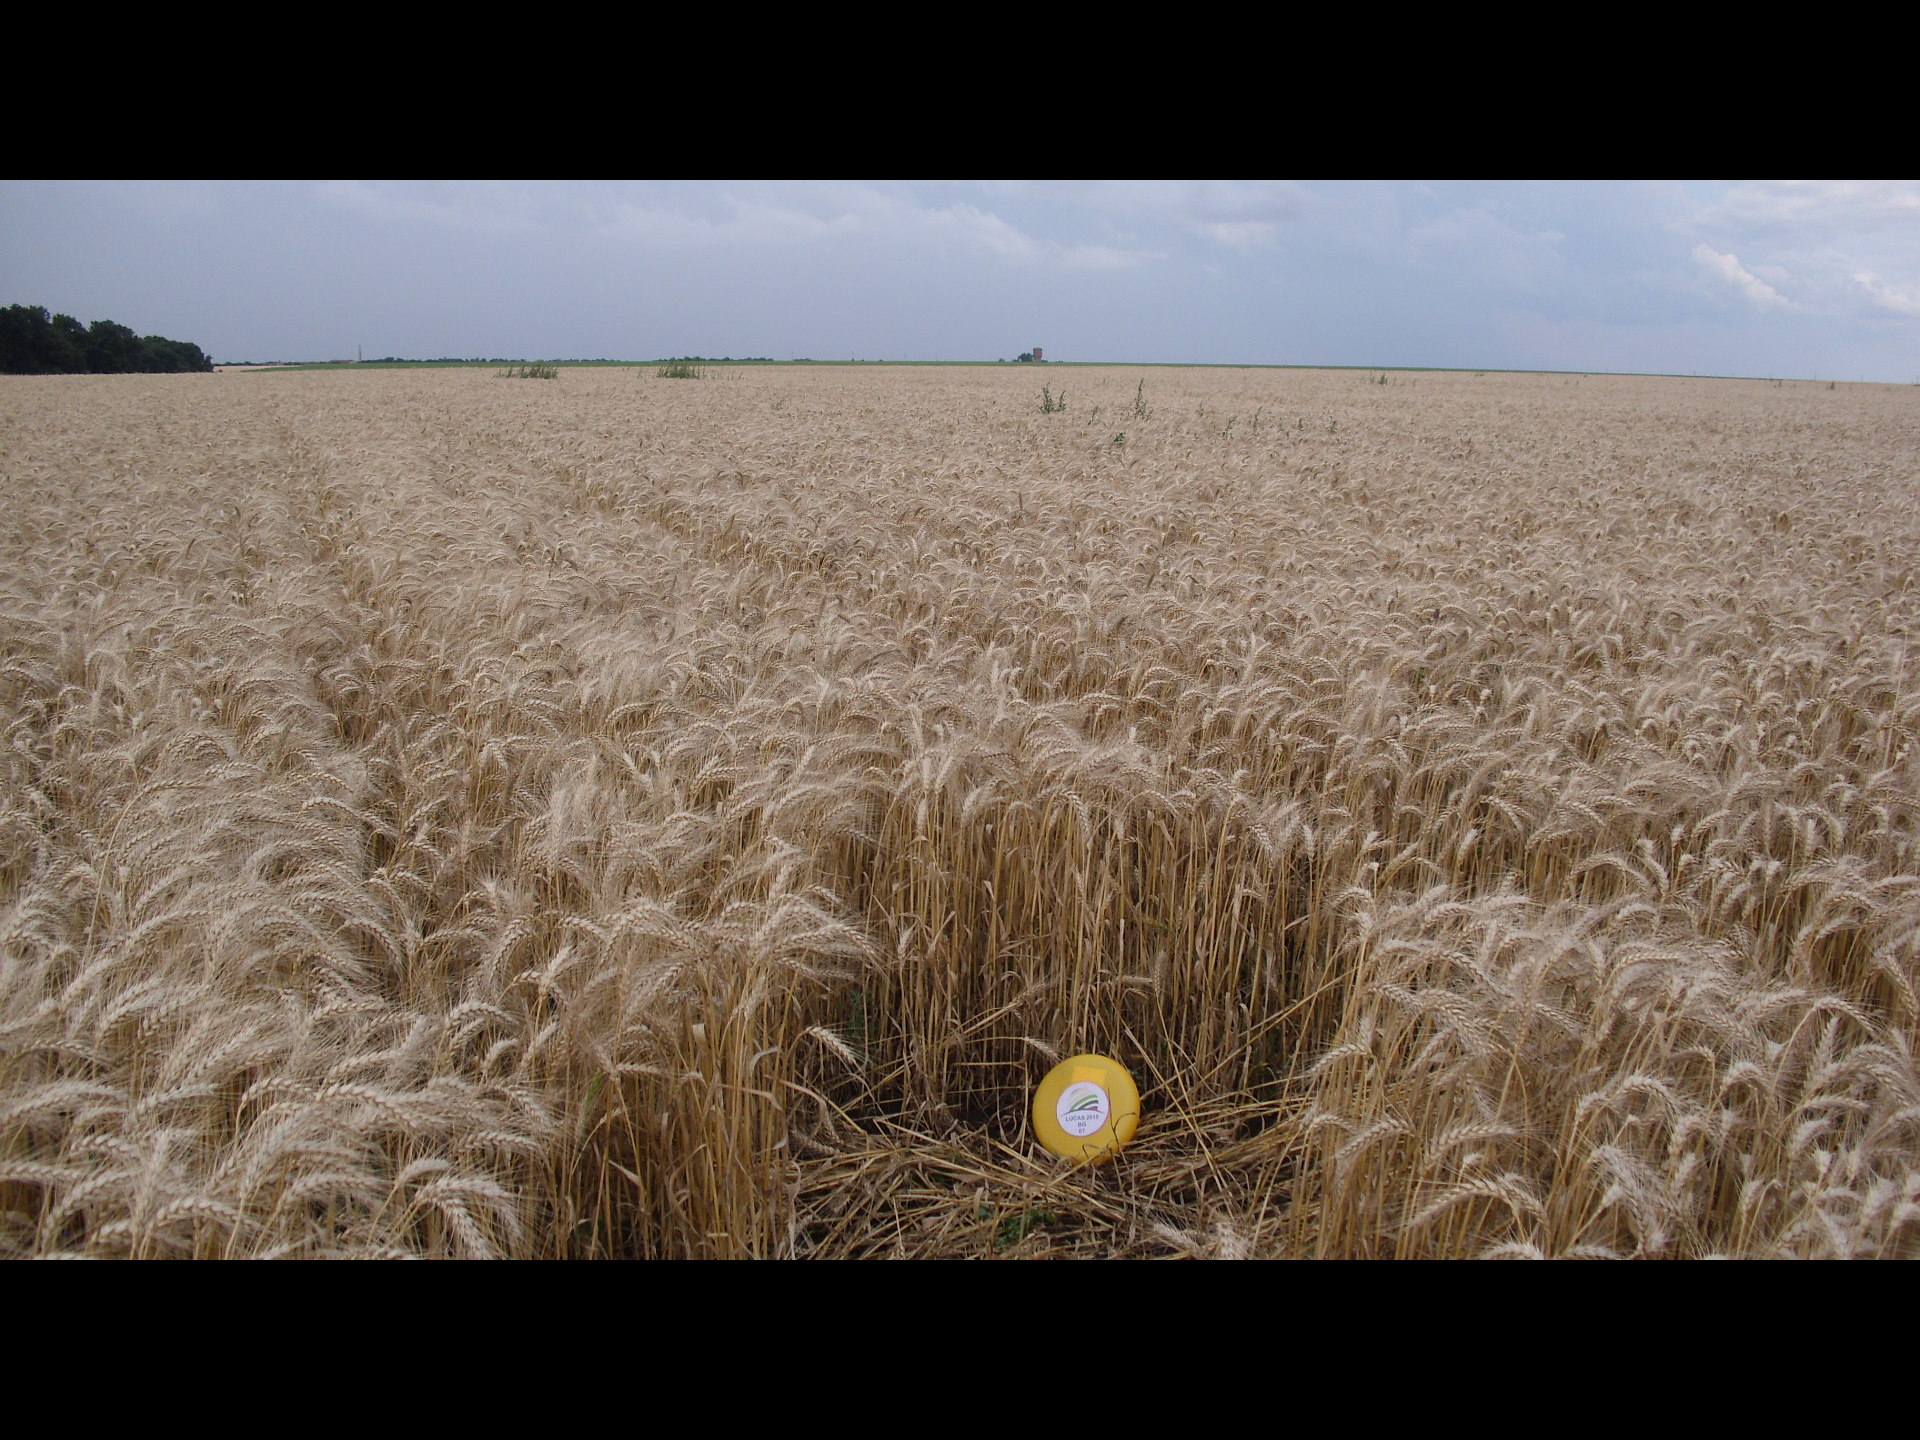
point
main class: Cropland
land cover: Common wheat
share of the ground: 10 - 25 %
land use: Agriculture (excluding fallow land and kitchen gardens)
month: June
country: BG
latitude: 43.5647
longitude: 23.4276
